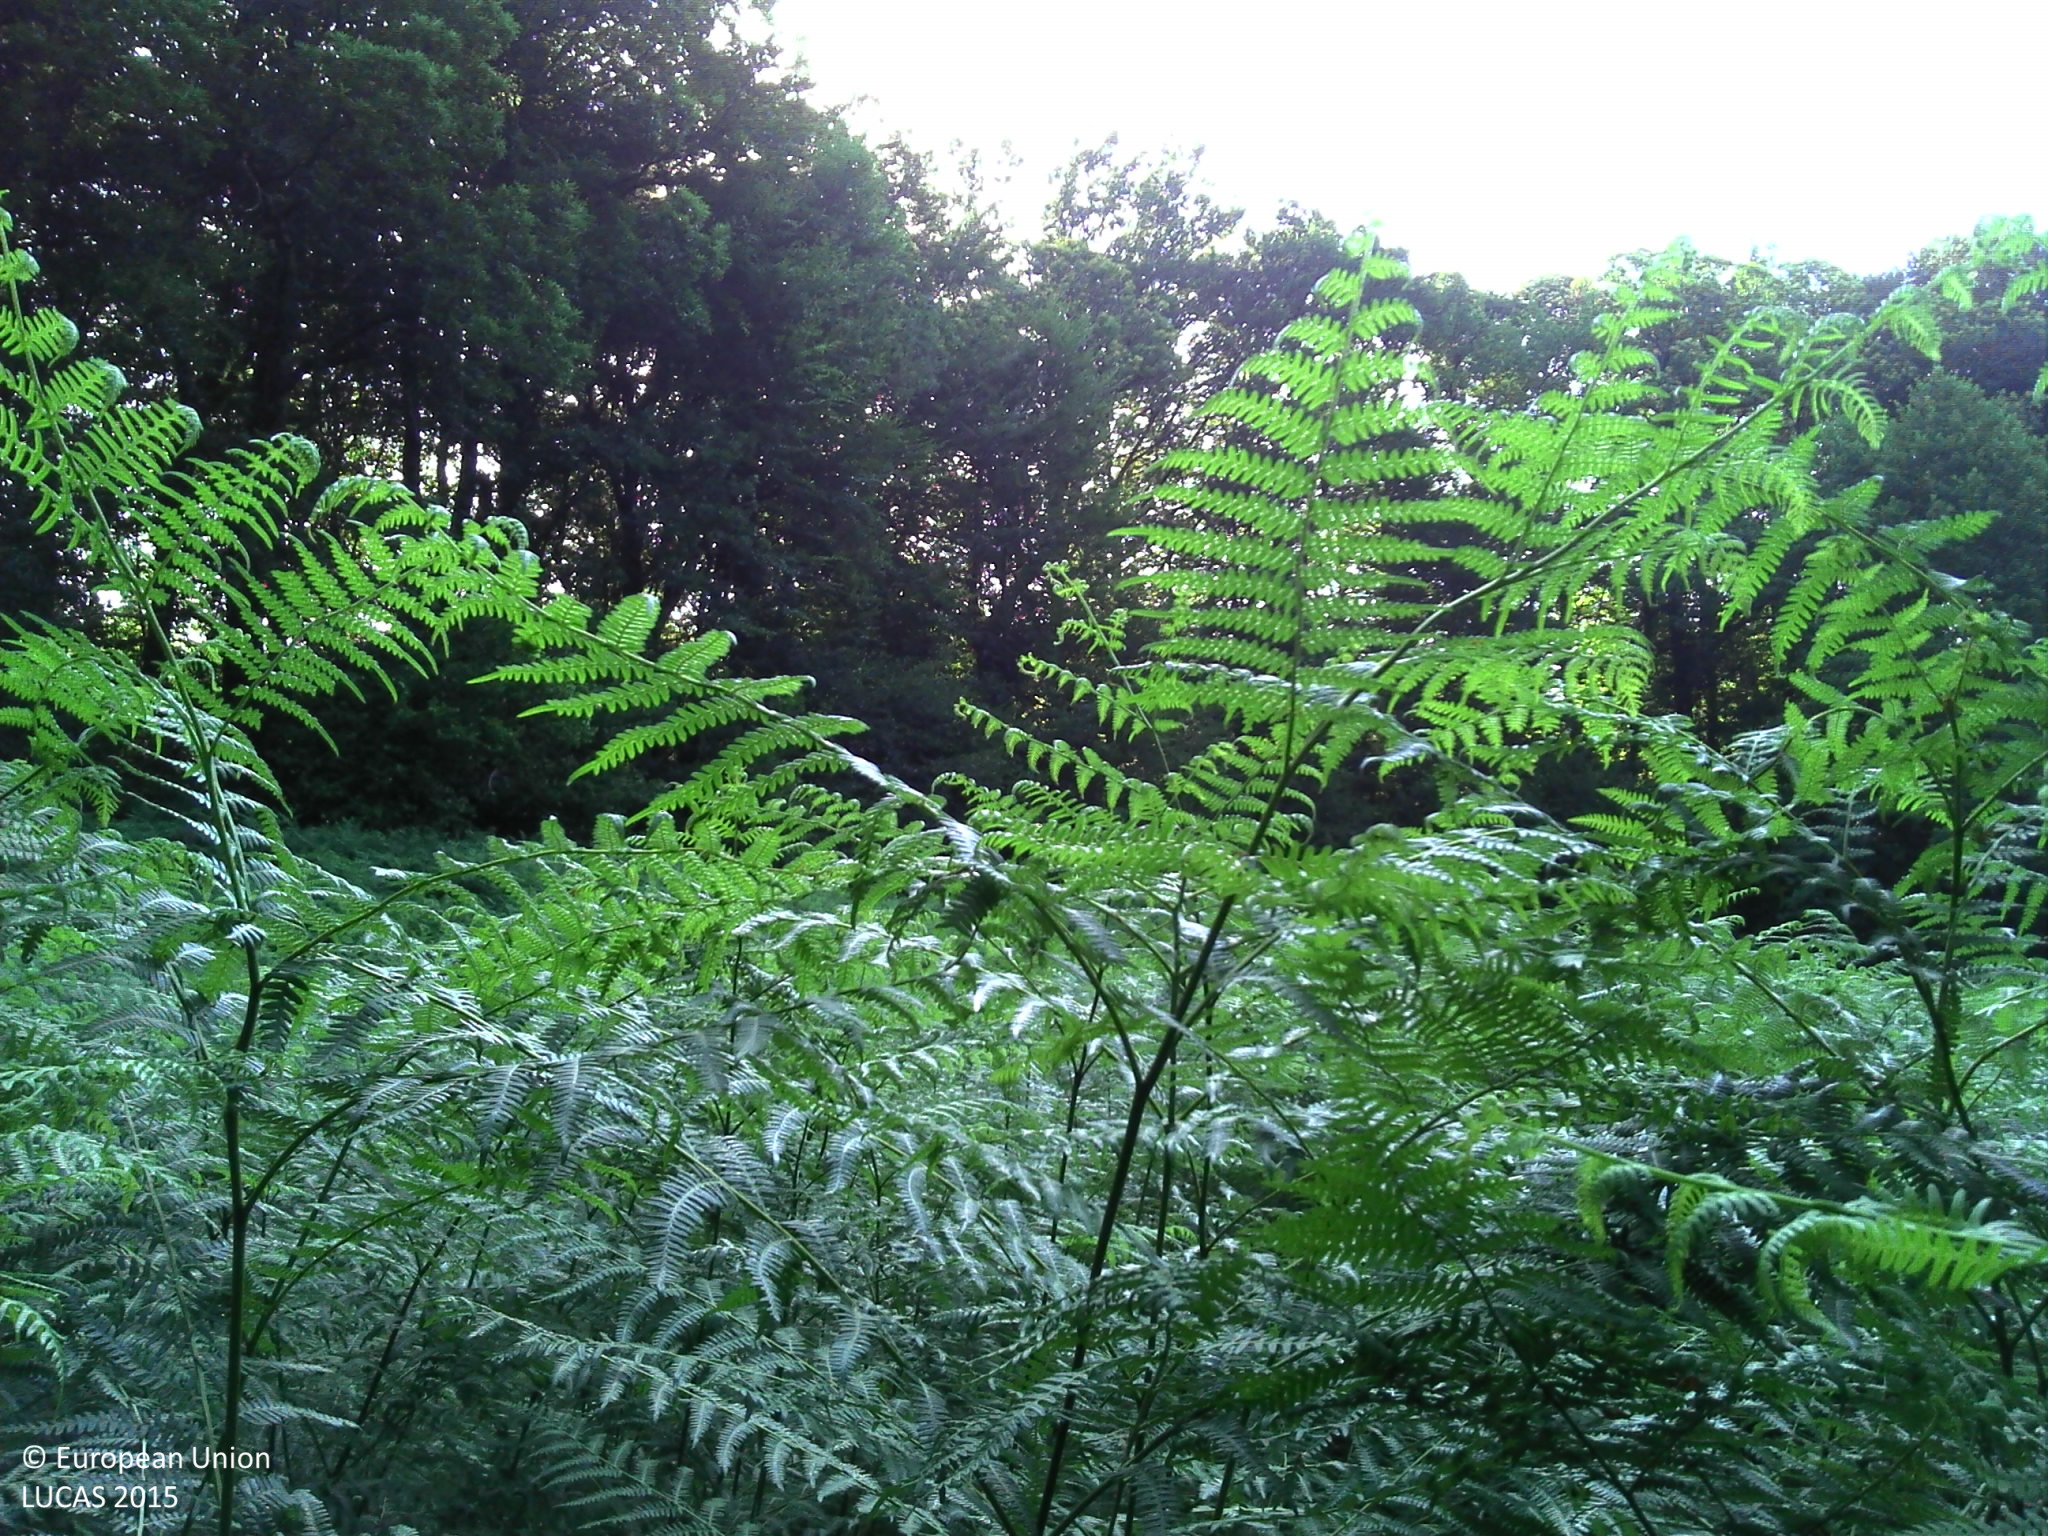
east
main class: Grassland
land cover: Spontaneously vegetated surfaces
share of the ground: > 75 %
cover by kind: herbaceous plants 95 %
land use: Fallow land
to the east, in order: Spontaneously vegetated surfaces; Broadleaved woodland; Fences; Broadleaved woodland; Other coniferous woodland; Grass margins; Paved roads, cycling and walking lanes; Grass margins; Fences; Grassland without tree/shrub cover; Fences; Spruce dominated coniferous woodland
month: July
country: FR
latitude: 45.8522
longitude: 1.7645
